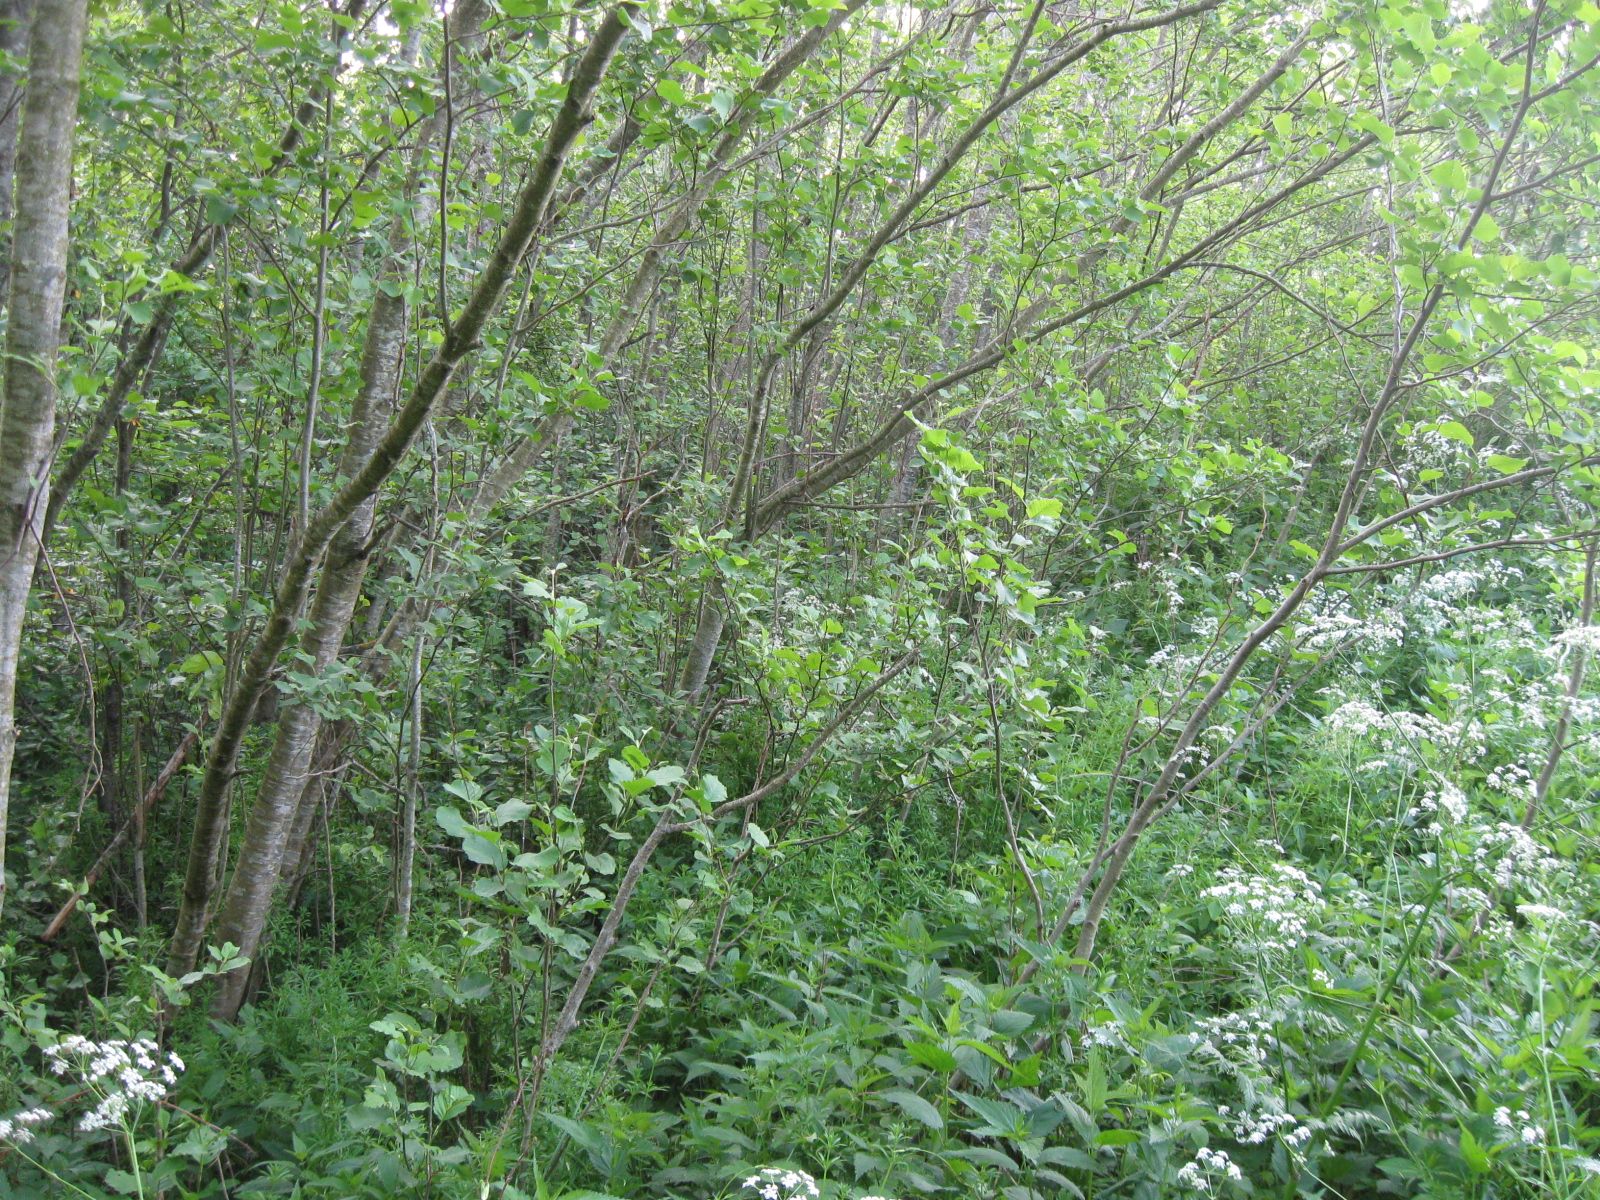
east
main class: Woodland
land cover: Broadleaved woodland
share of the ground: 50 - 75 %
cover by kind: broadleaved forest trees 65 %, herbaceous plants 35 %
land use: Semi-natural and natural areas not in use
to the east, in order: Broadleaved woodland; Spontaneously vegetated surfaces; Paved roads, cycling and walking lanes; Shruby margins; Broadleaved woodland; Grassland without tree/shrub cover
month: June
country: LT
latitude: 54.5496
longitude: 23.8957
